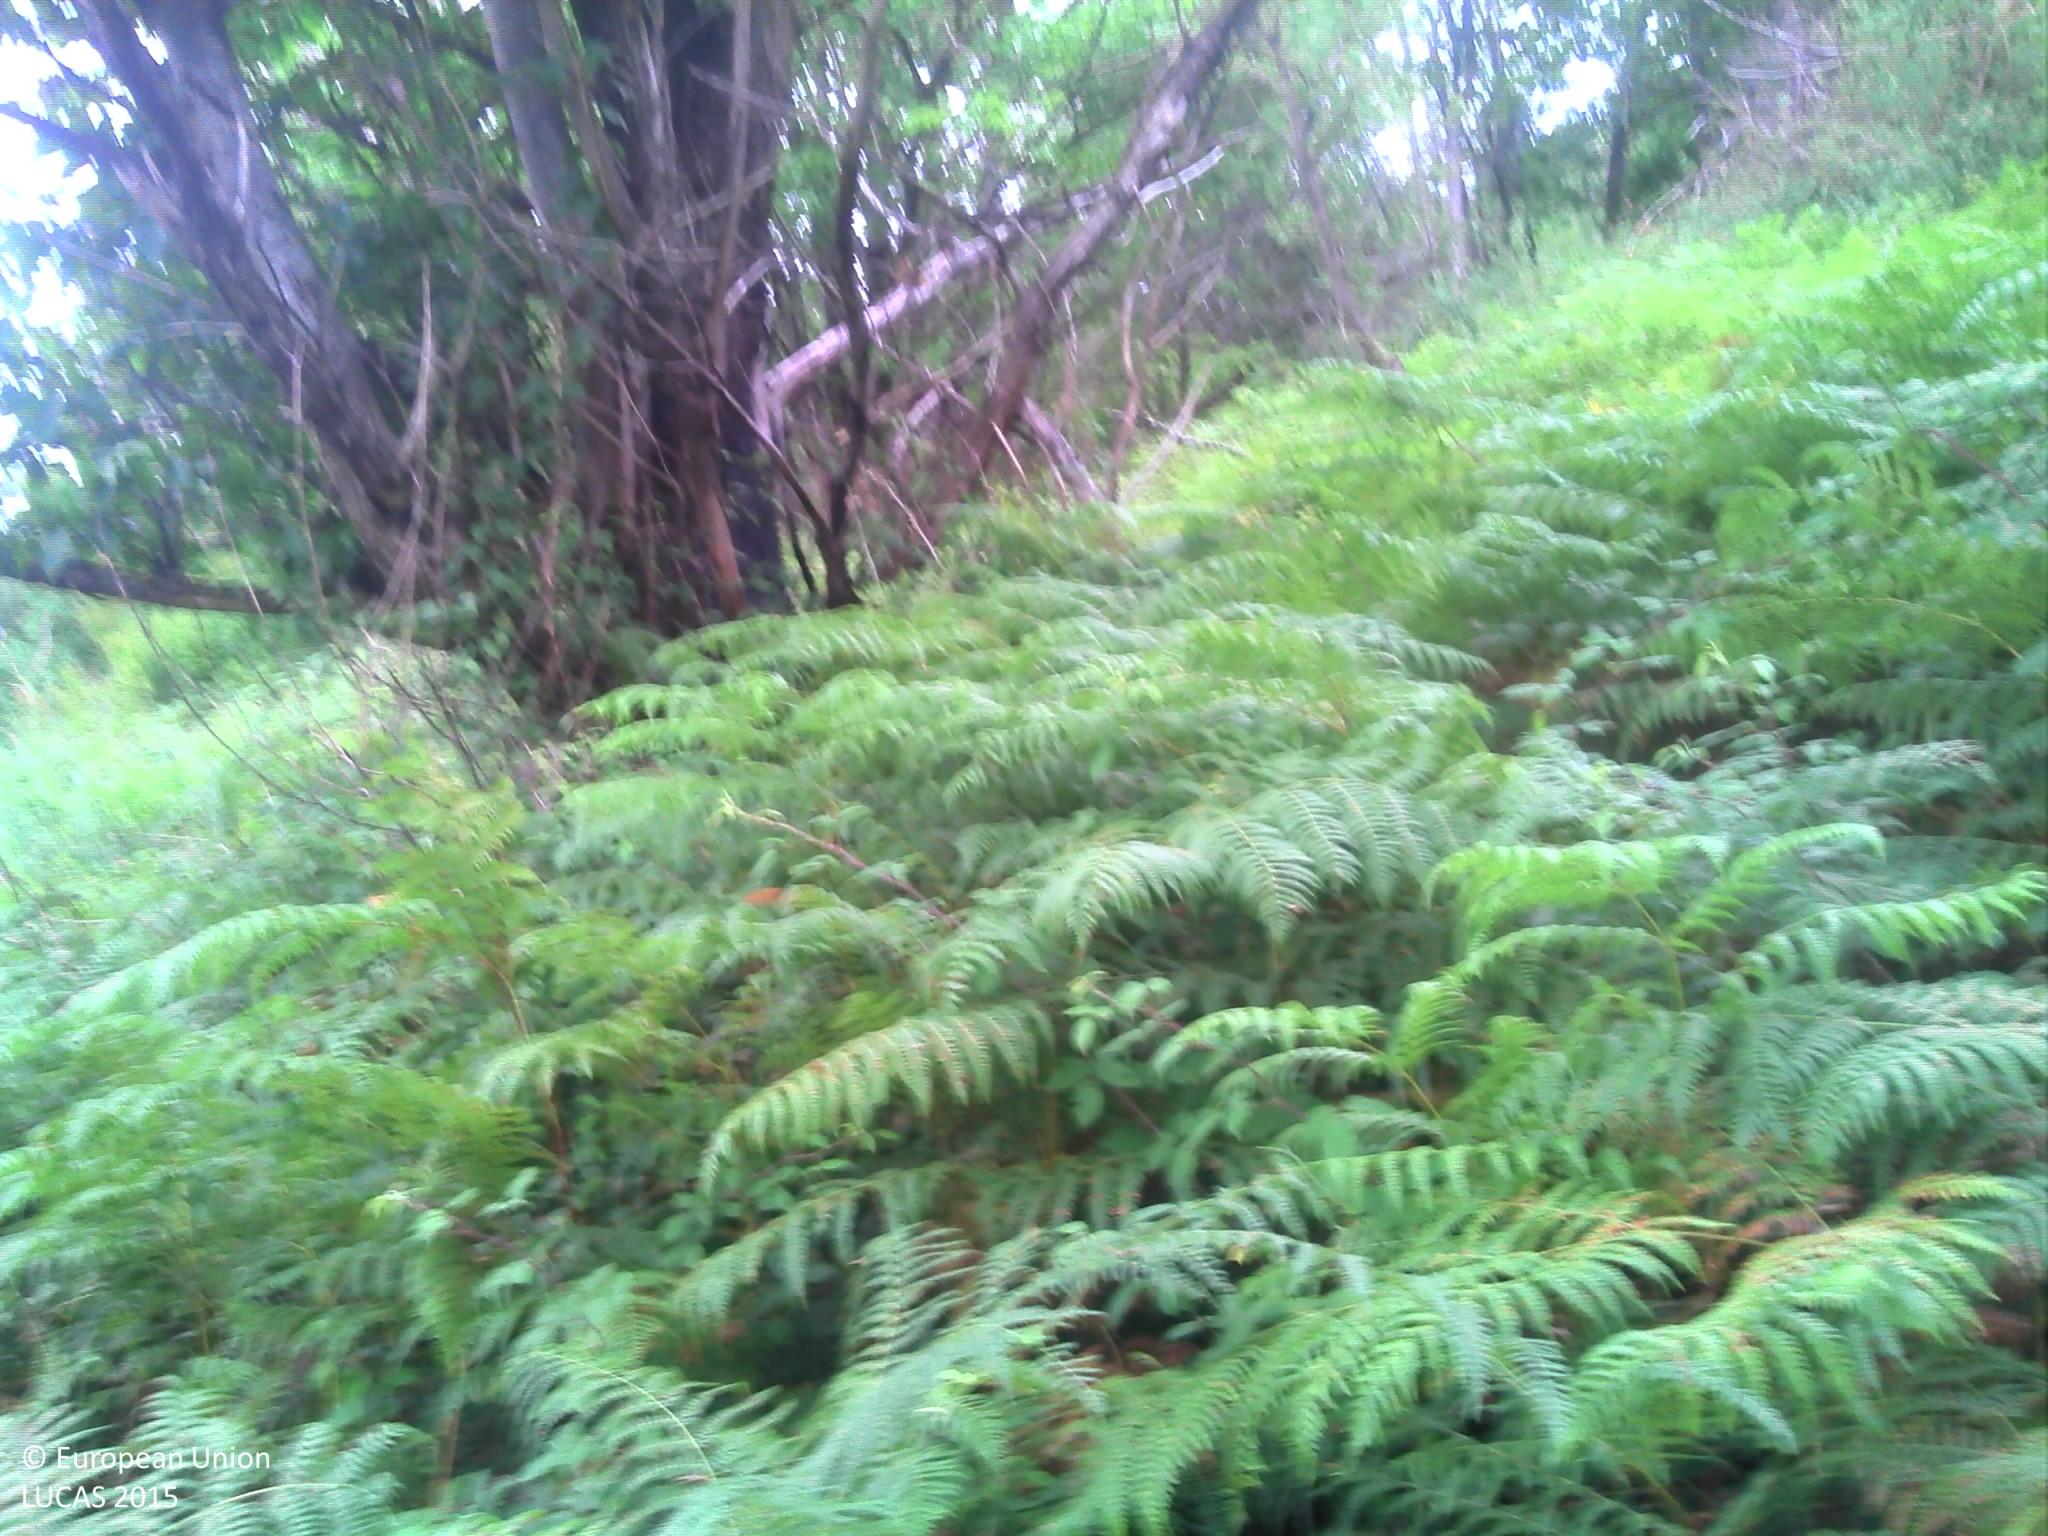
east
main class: Woodland
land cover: Broadleaved woodland
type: thermophilous deciduous forest
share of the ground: > 75 %
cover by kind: broadleaved forest trees 95 %, shrubs 5 %
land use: Forestry
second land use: Agriculture (excluding fallow land and kitchen gardens)
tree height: > 5 m
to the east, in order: Broadleaved woodland; Rock outcrops; Broadleaved woodland; Tracks; Broadleaved woodland; Shrubland without tree cover; Spontaneously vegetated surfaces; Broadleaved woodland
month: August
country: FR
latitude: 43.2400
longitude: -1.1332
